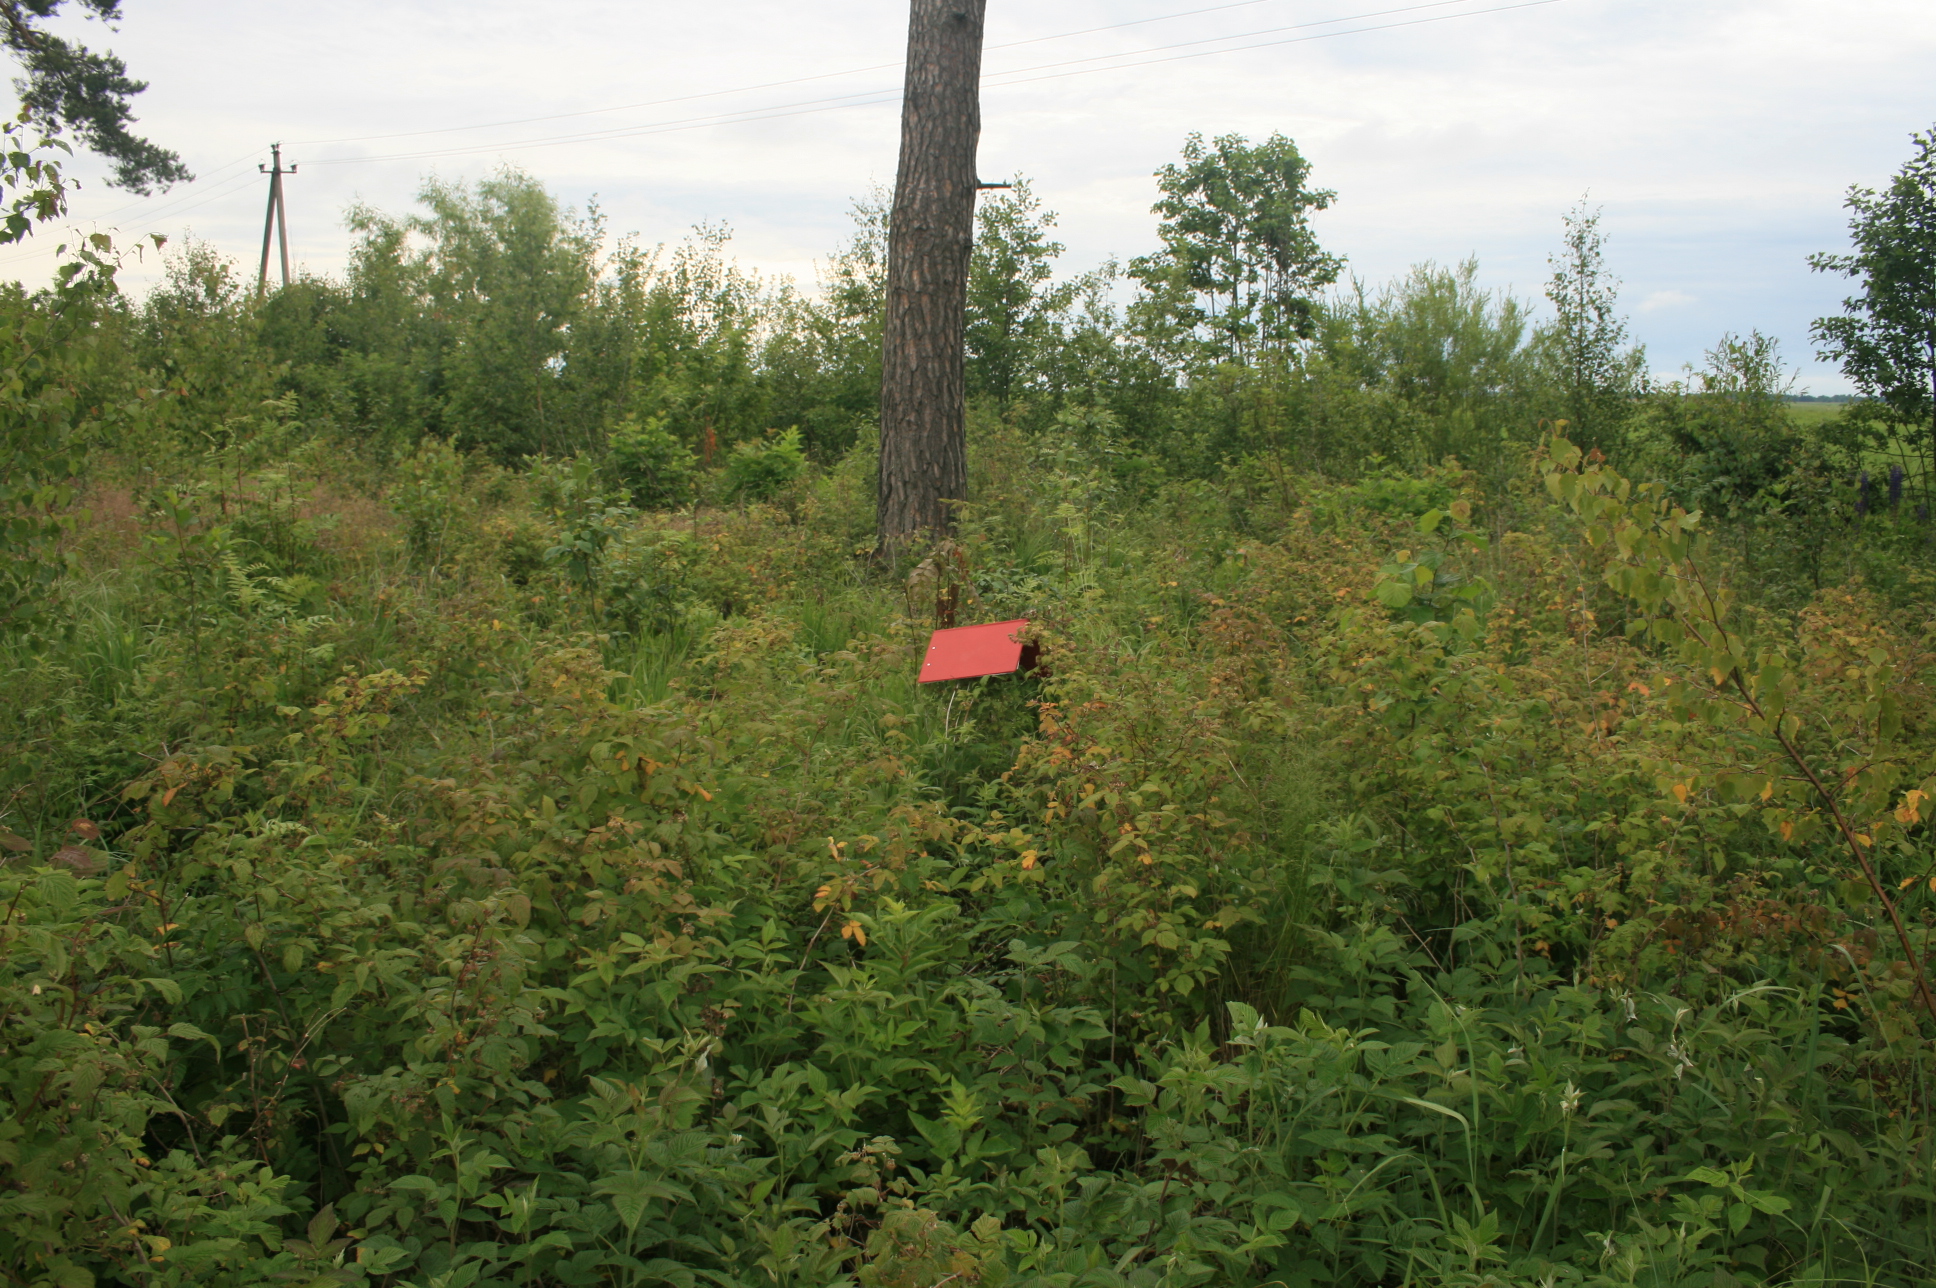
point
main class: Woodland
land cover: Broadleaved woodland
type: non-riverine alder, birch or aspen forest
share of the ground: 25 - 50 %
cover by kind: shrubs 50 %, broadleaved forest trees 30 %, coniferous forest trees 10 %, herbaceous plants 10 %
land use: Forestry
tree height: < 5 m
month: June
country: LT
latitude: 55.2289
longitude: 22.1150
